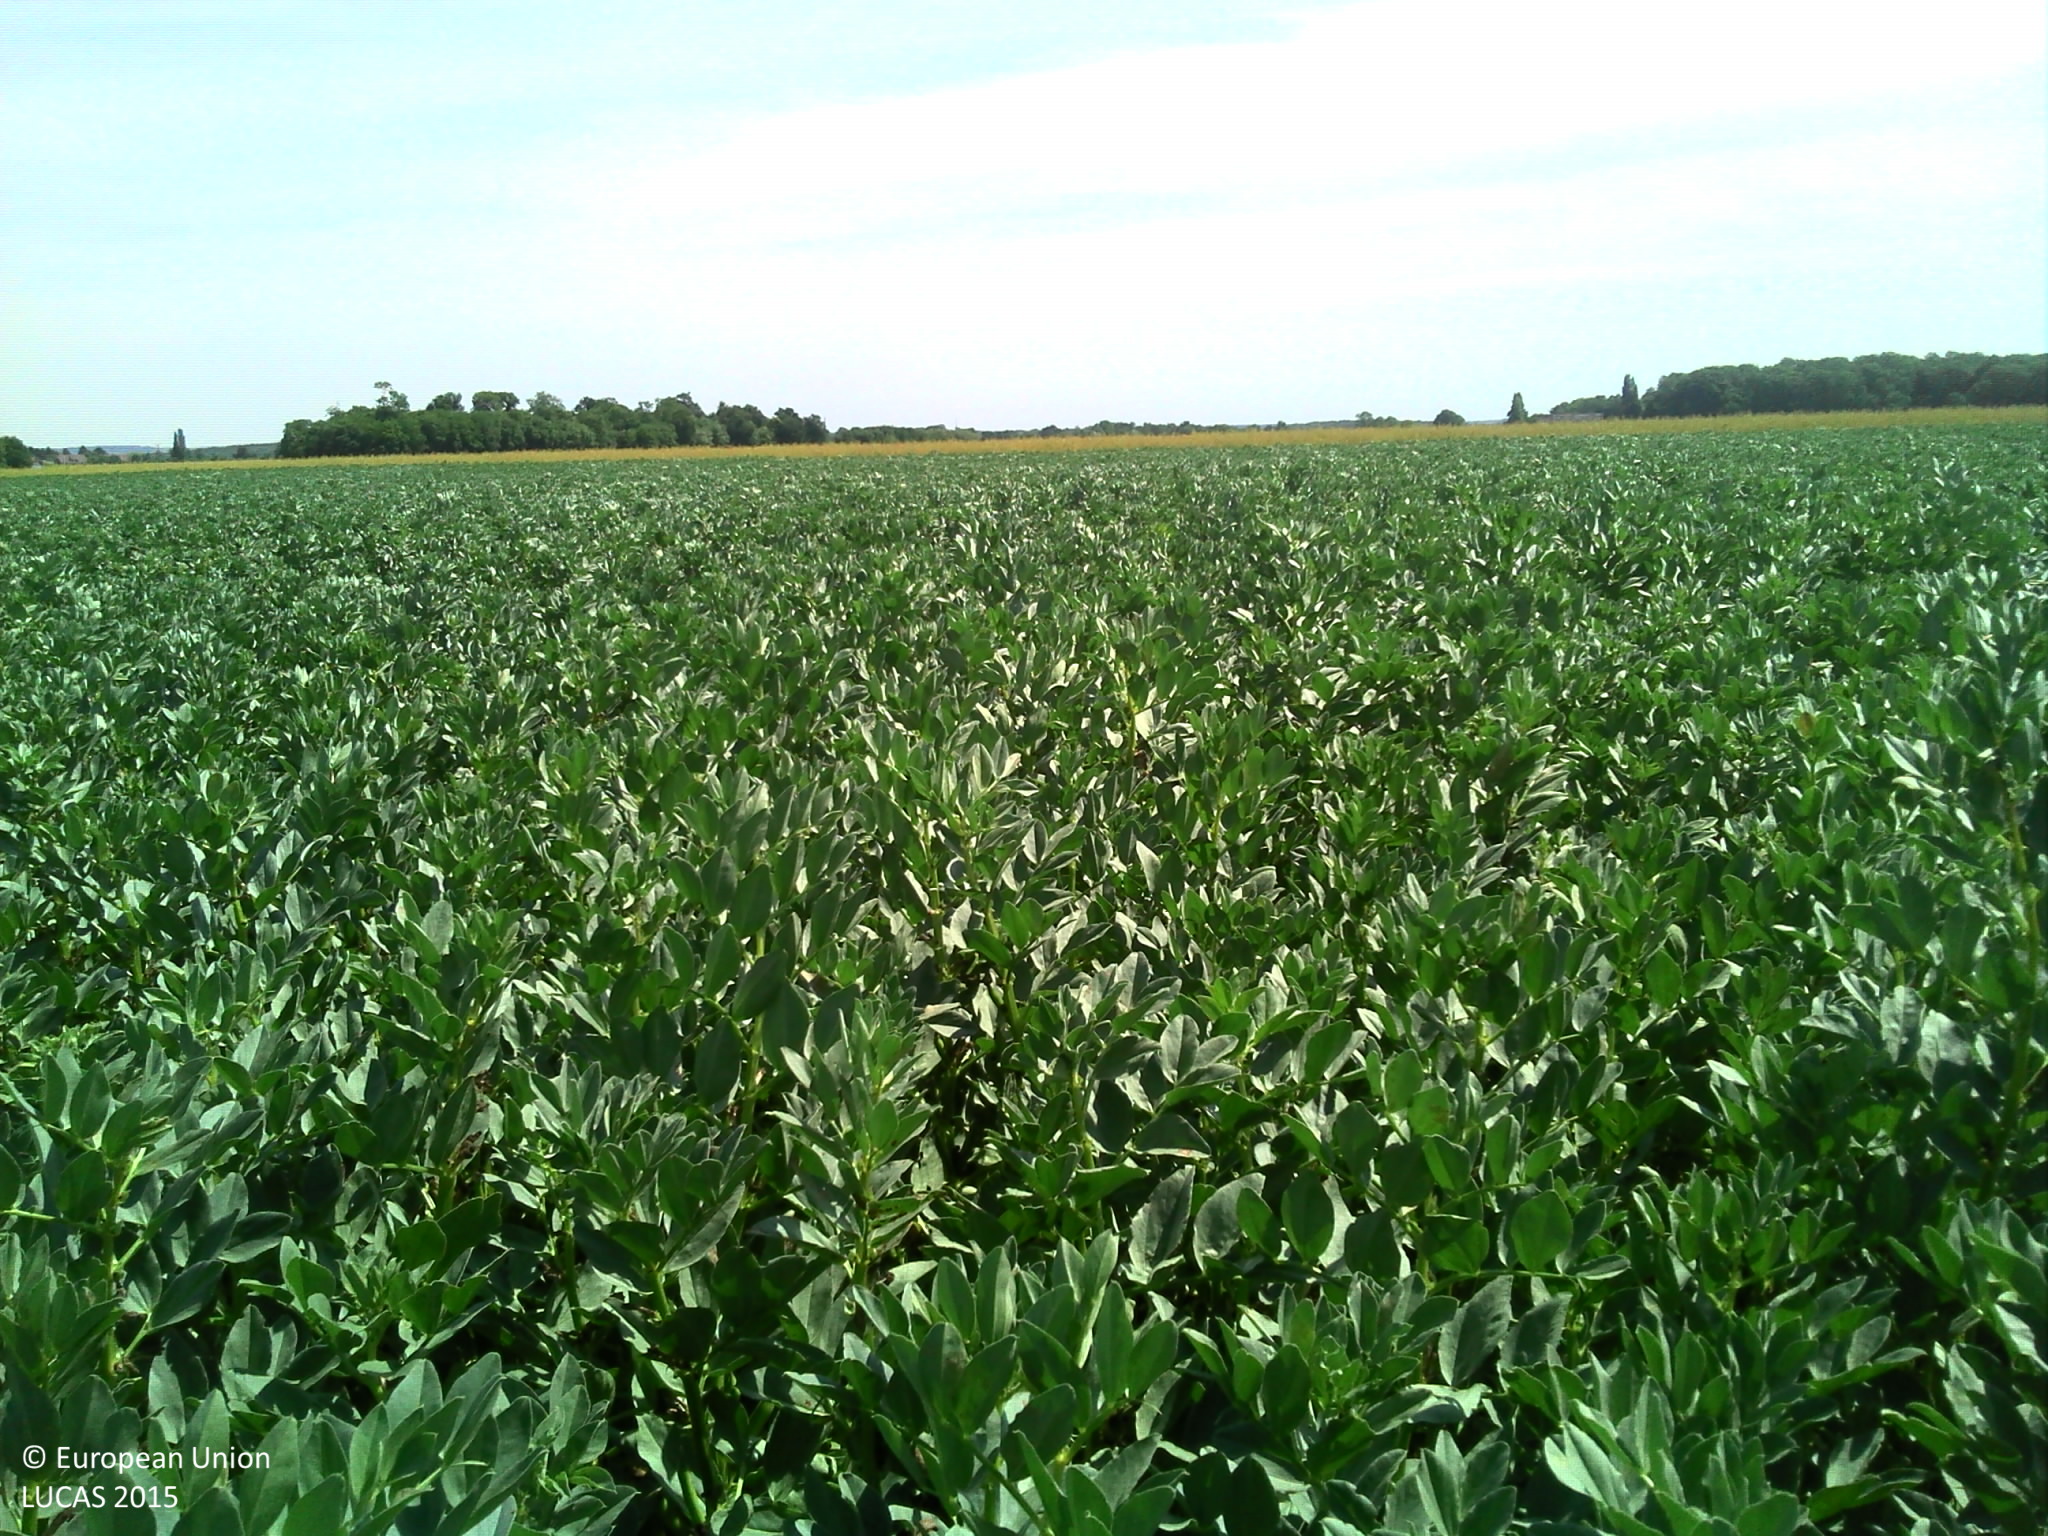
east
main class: Cropland
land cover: Dry pulses
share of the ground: > 75 %
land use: Agriculture (excluding fallow land and kitchen gardens)
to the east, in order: Dry pulses; Rape and turnip rape; Barley; Grass margins; Paved roads, cycling and walking lanes; Grass margins; Sugar beet
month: June
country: FR
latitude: 49.1616
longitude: 1.2723
